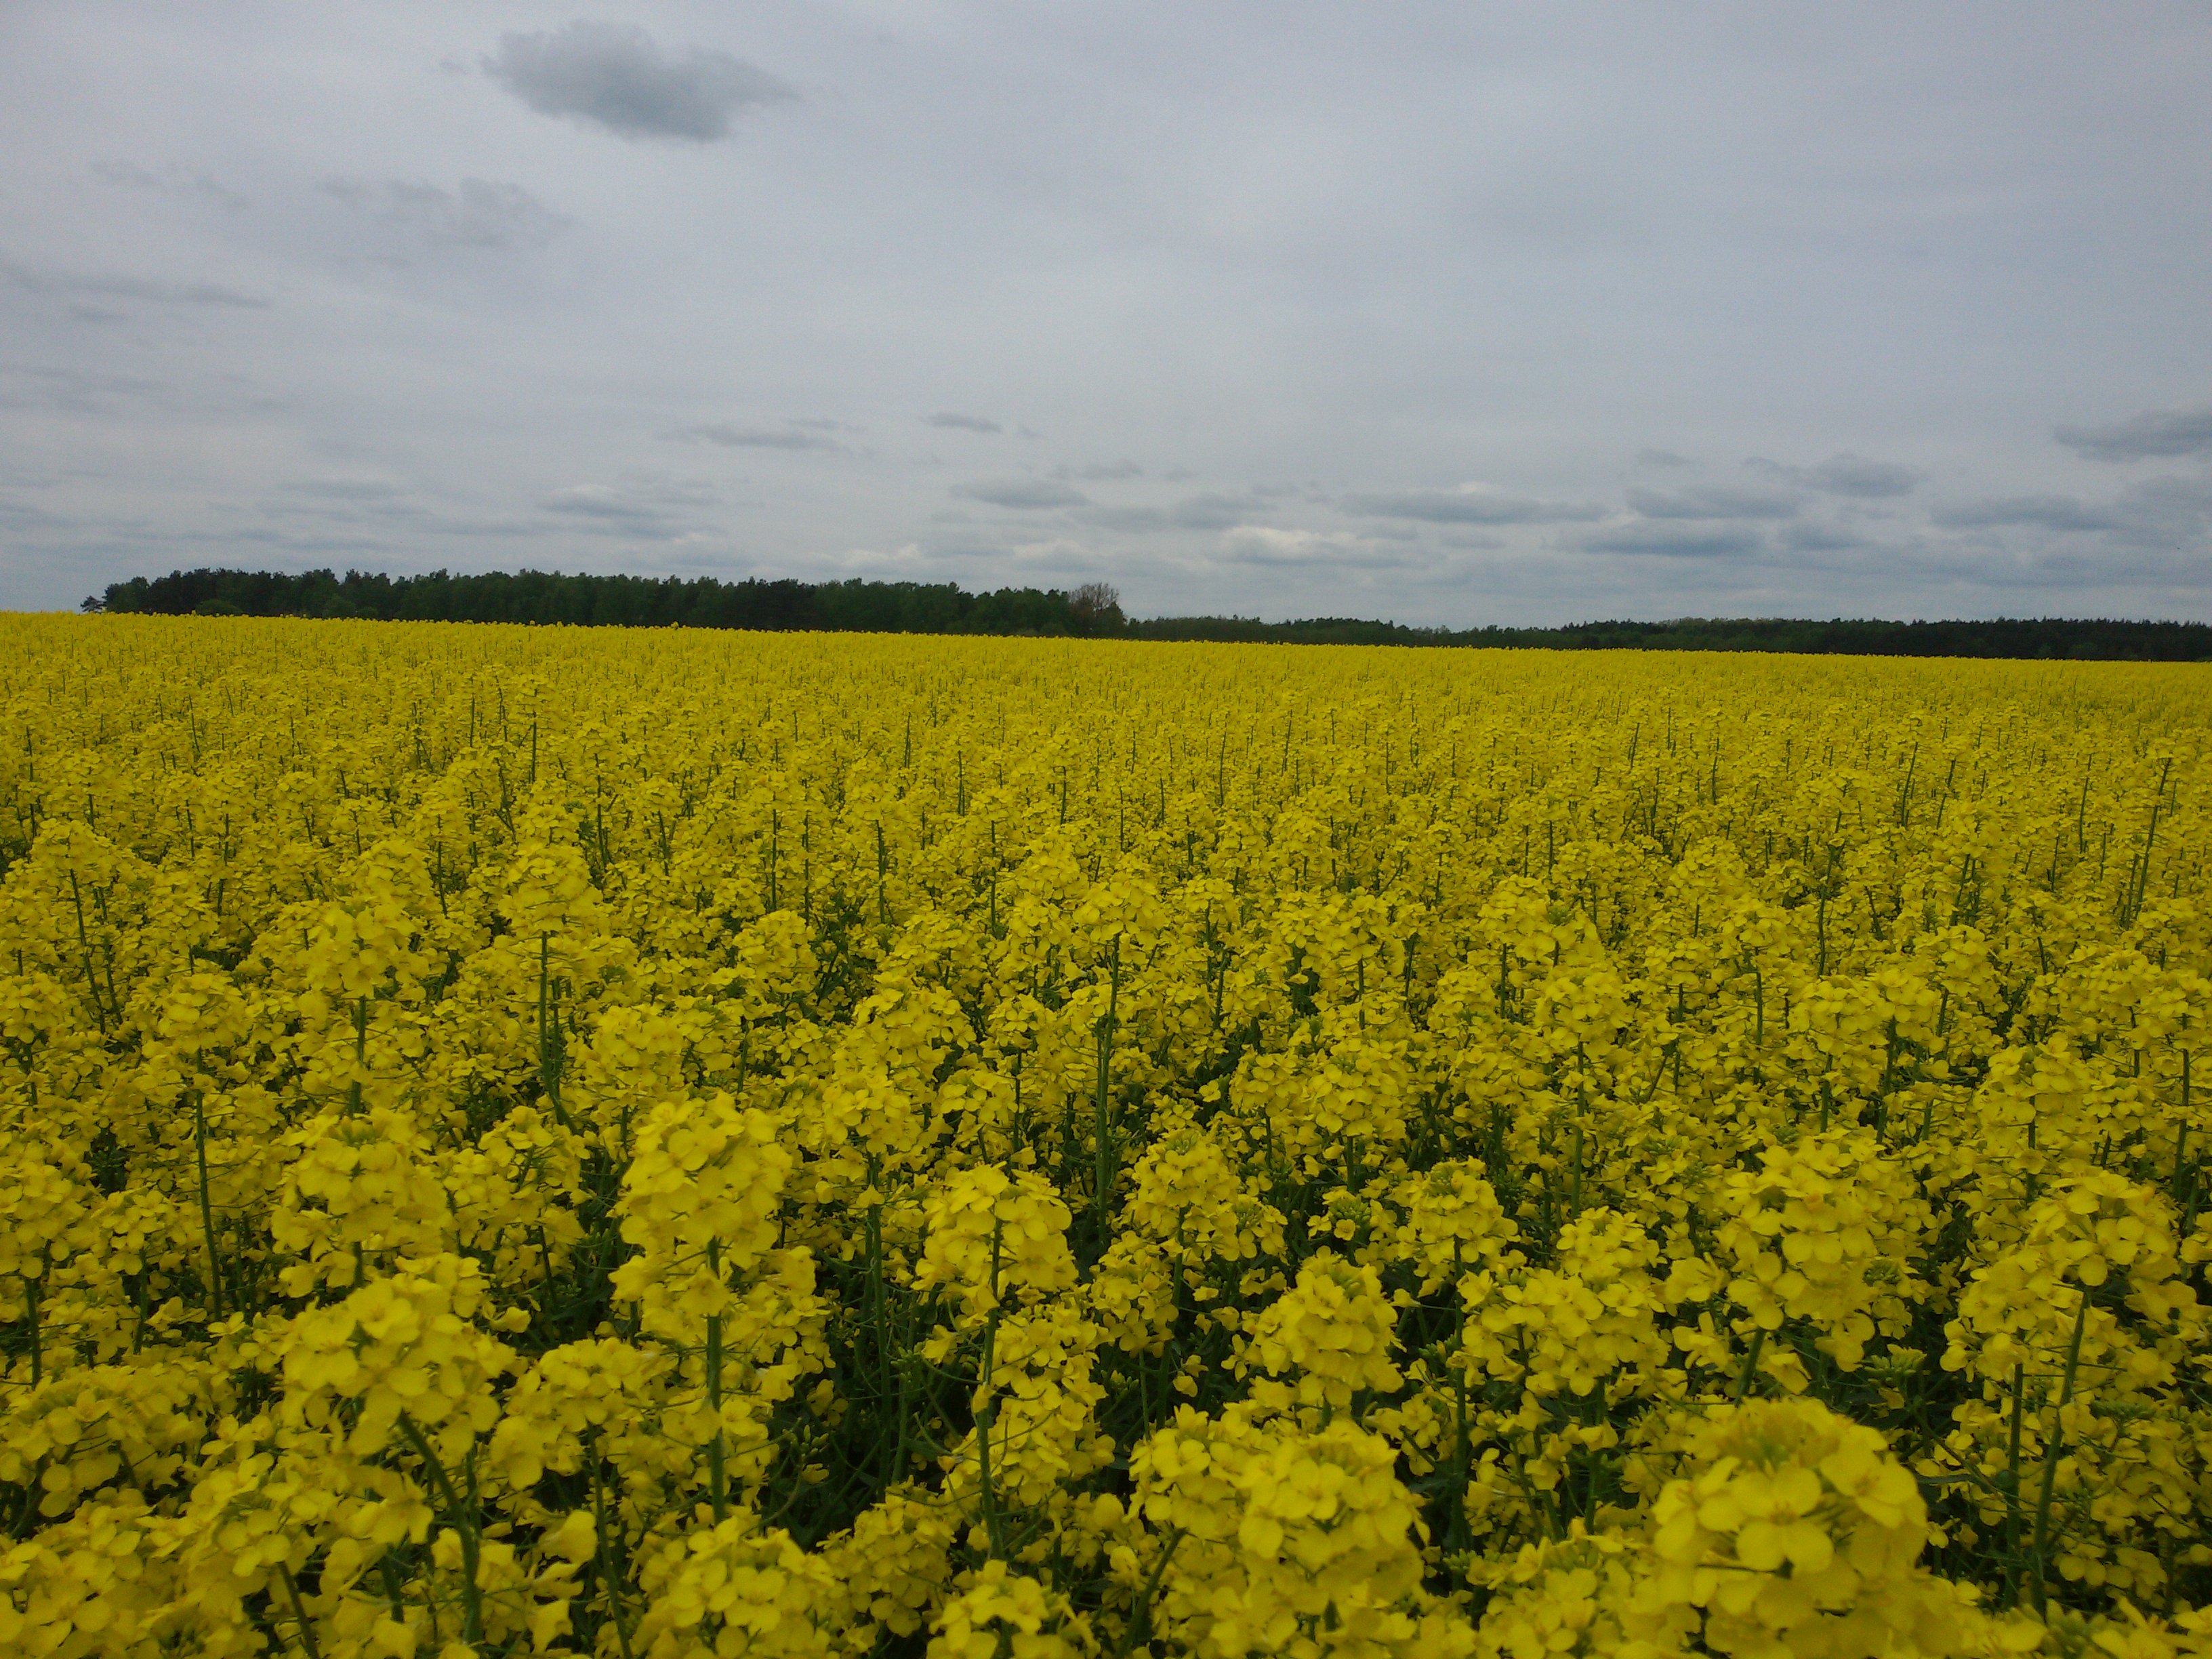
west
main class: Cropland
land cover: Rape and turnip rape
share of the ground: > 75 %
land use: Agriculture (excluding fallow land and kitchen gardens)
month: May
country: PL
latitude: 53.4818
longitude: 17.1071
